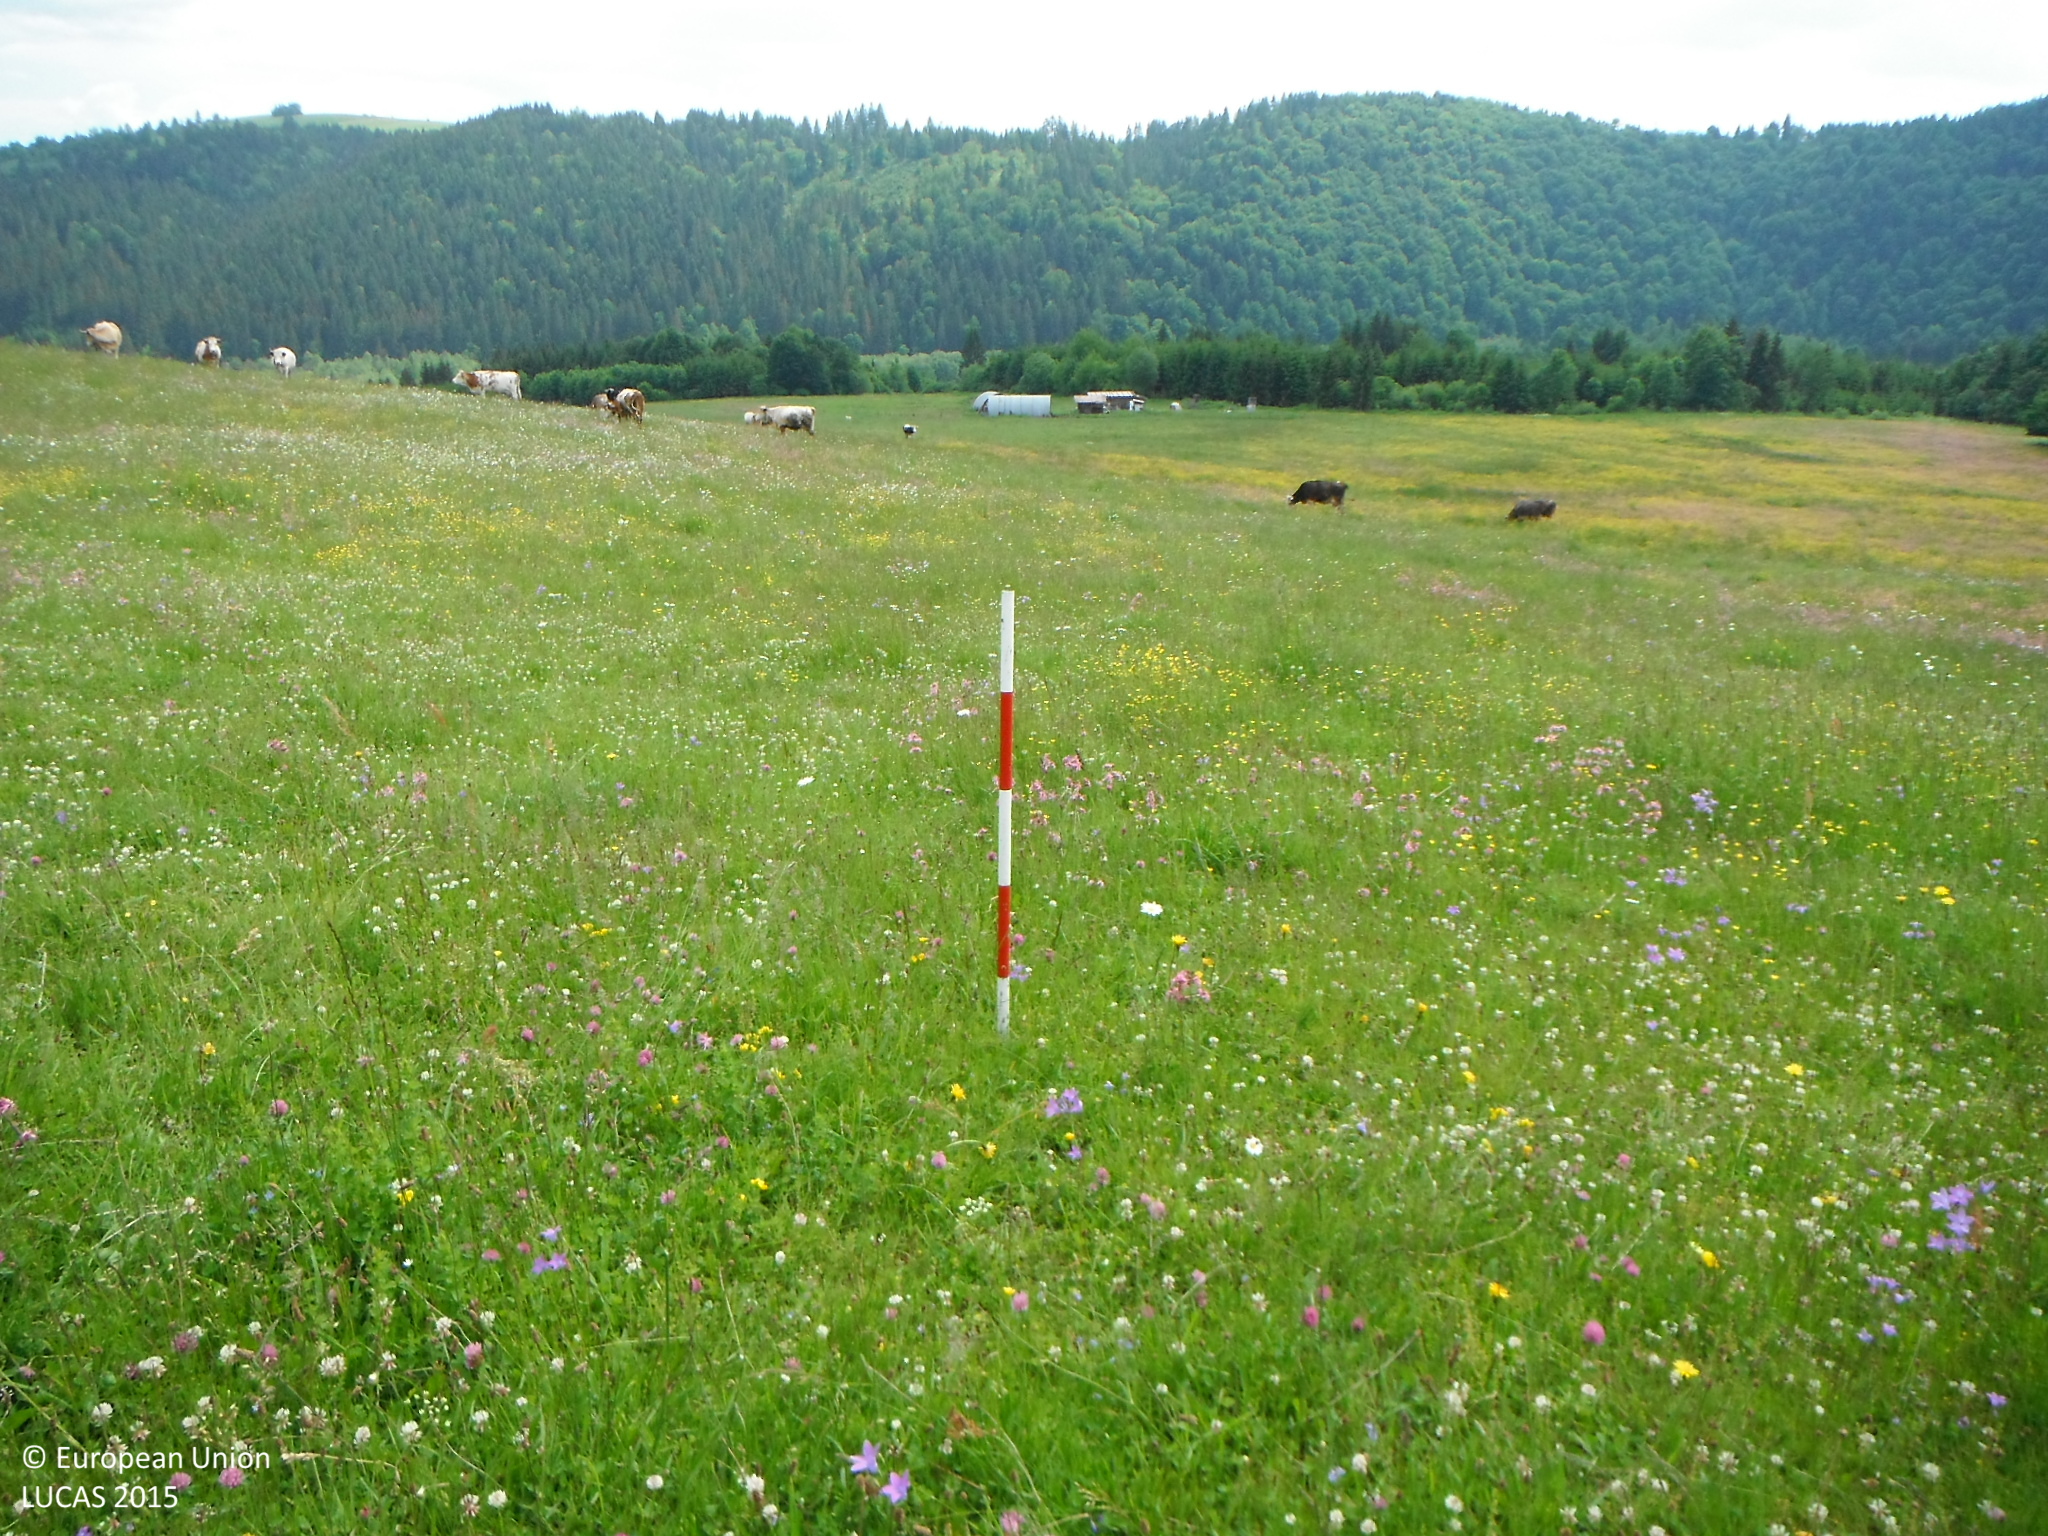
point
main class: Grassland
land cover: Grassland without tree/shrub cover
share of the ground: > 75 %
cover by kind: herbaceous plants 100 %
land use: Agriculture (excluding fallow land and kitchen gardens)
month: June
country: SK
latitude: 48.8266
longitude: 19.7125
